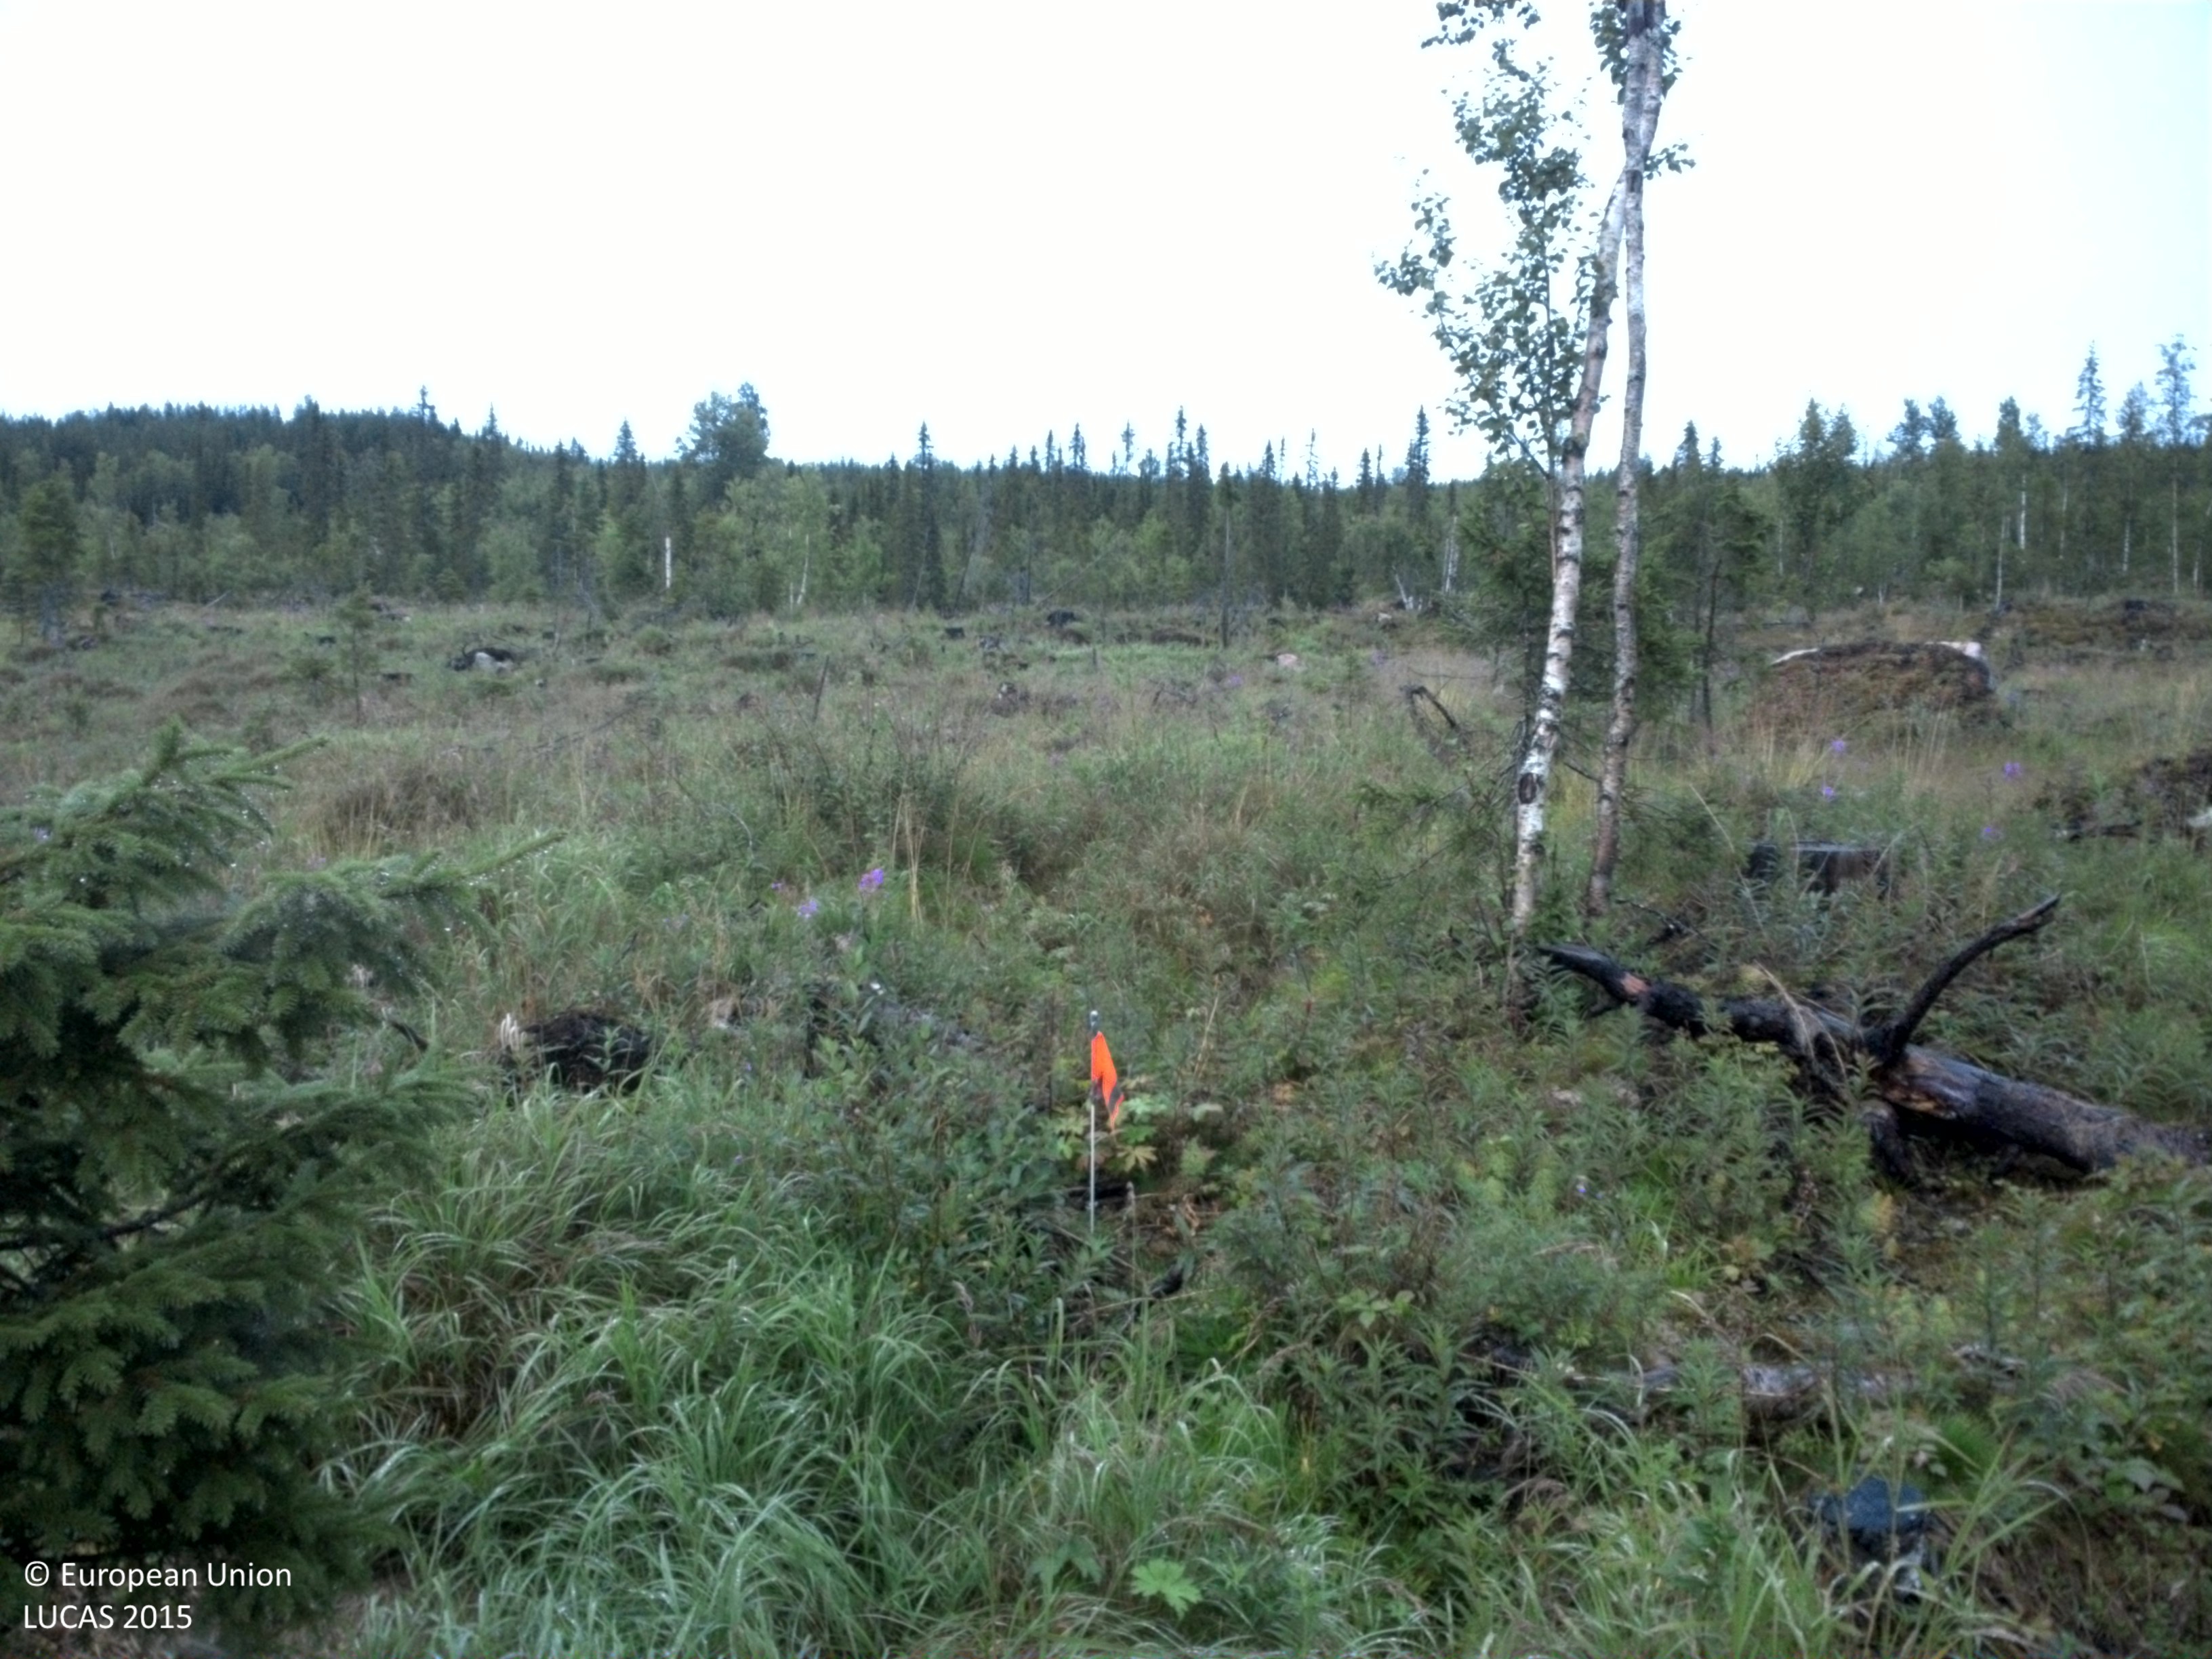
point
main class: Grassland
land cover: Grassland with sparse tree/shrub cover
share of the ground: > 75 %
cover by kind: herbaceous plants 90 %, coniferous forest trees 5 %, shrubs 5 %
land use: Forestry
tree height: < 5 m
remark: Clear cut
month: August
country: SE
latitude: 64.8483
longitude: 16.8606
